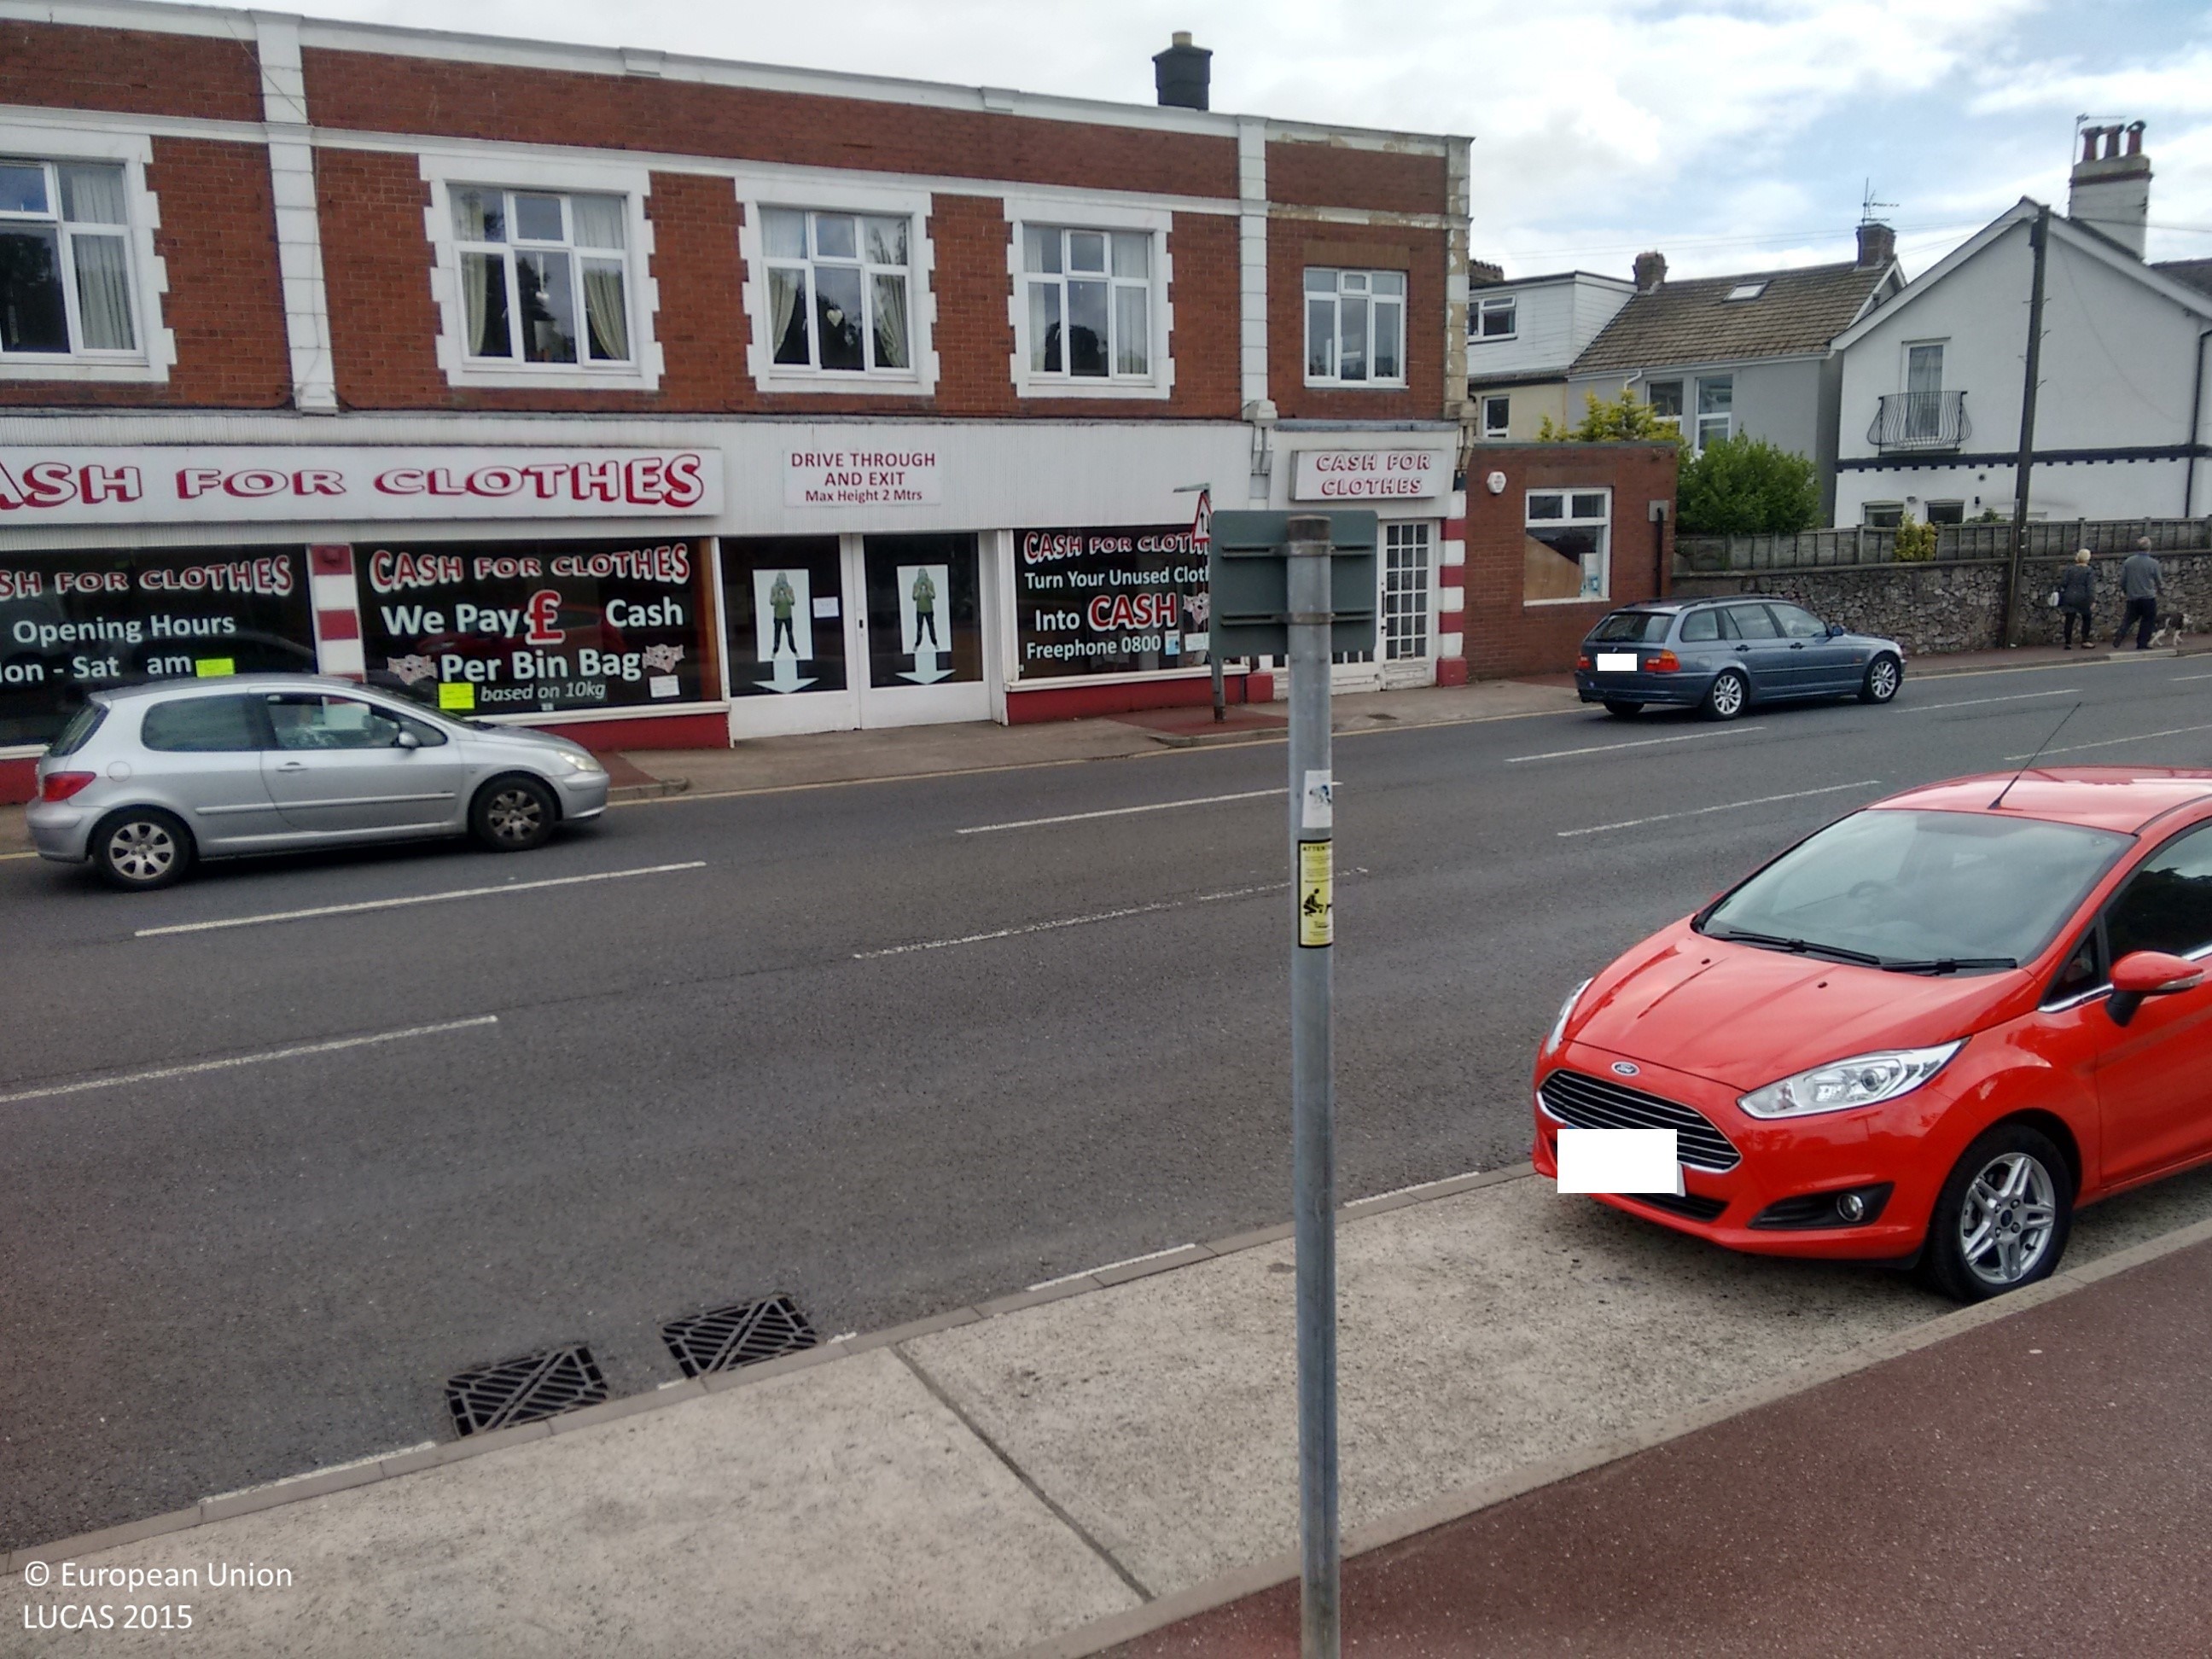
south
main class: Grassland
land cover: Grassland with sparse tree/shrub cover
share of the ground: > 75 %
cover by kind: herbaceous plants 95 %, broadleaved forest trees 5 %
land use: Amenities, museums, leisure
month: July
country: GB
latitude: 50.4453
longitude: -3.5613
